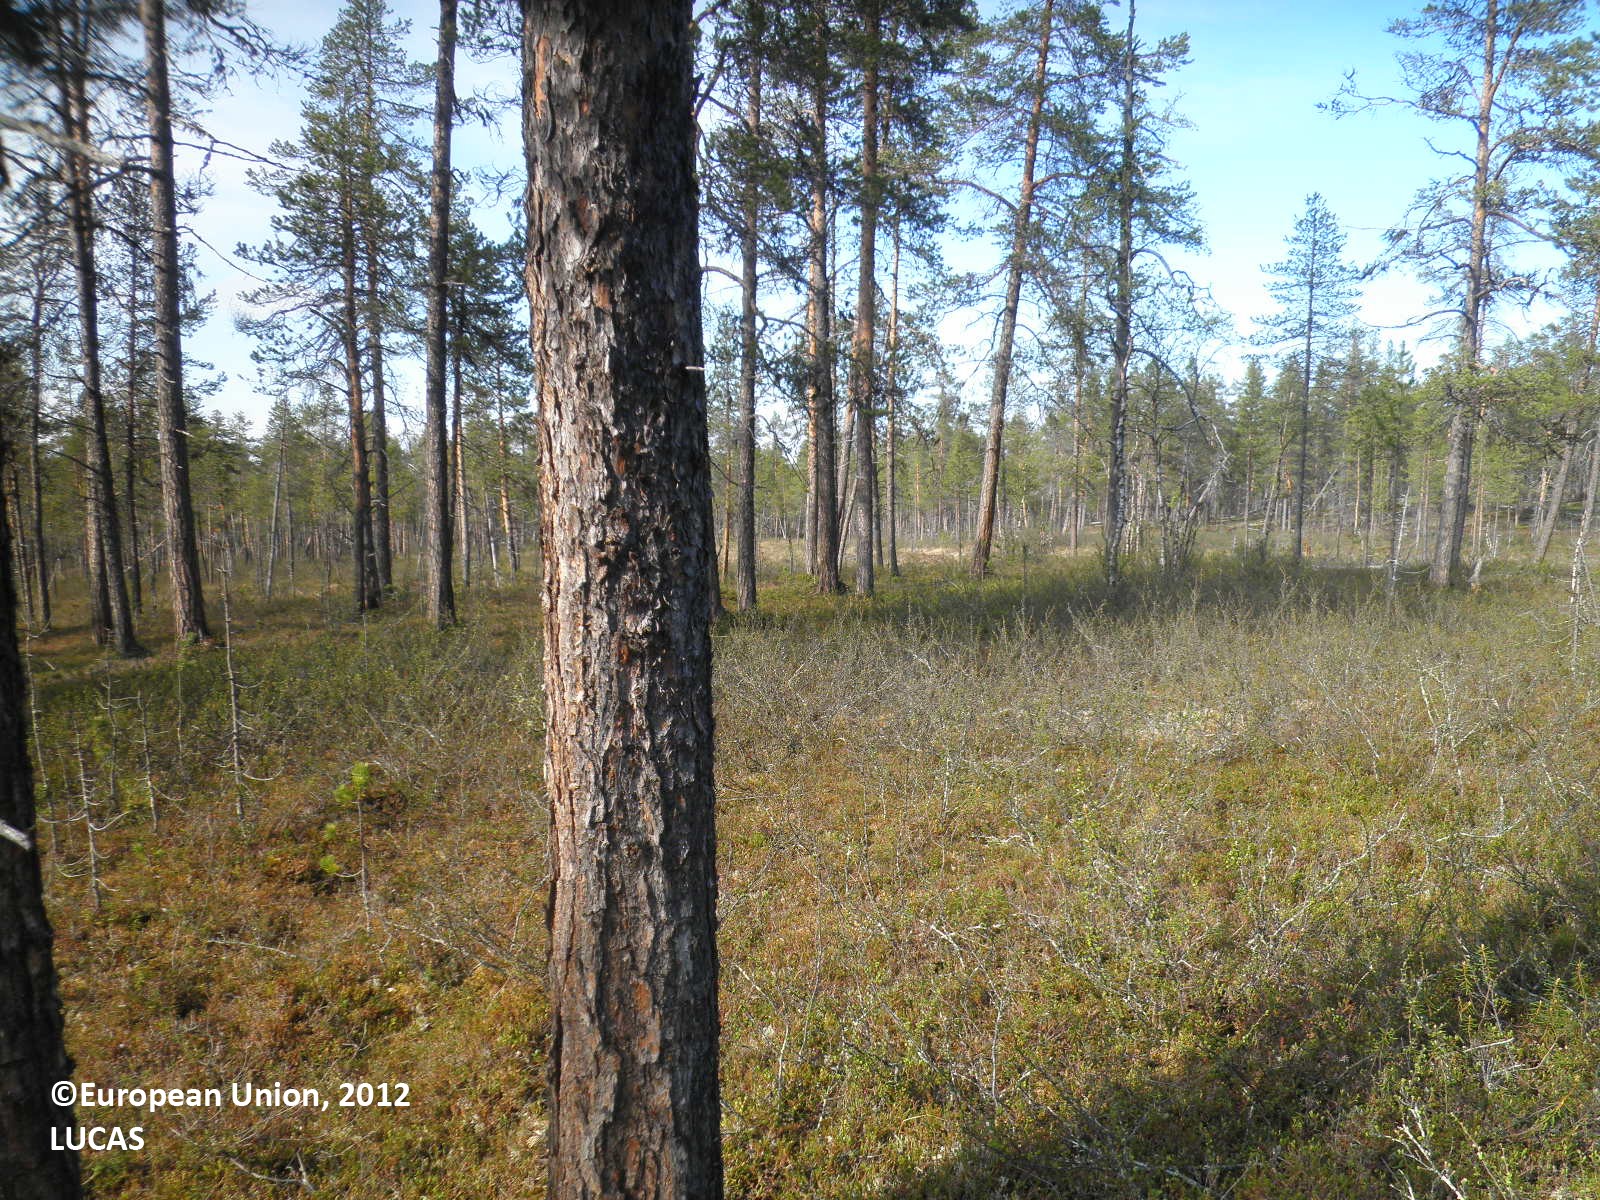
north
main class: Woodland
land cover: Pine dominated coniferous woodland
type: boreal forest
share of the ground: 25 - 50 %
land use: Forestry
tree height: > 5 m
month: June
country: FI
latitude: 68.9058
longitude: 26.2498
